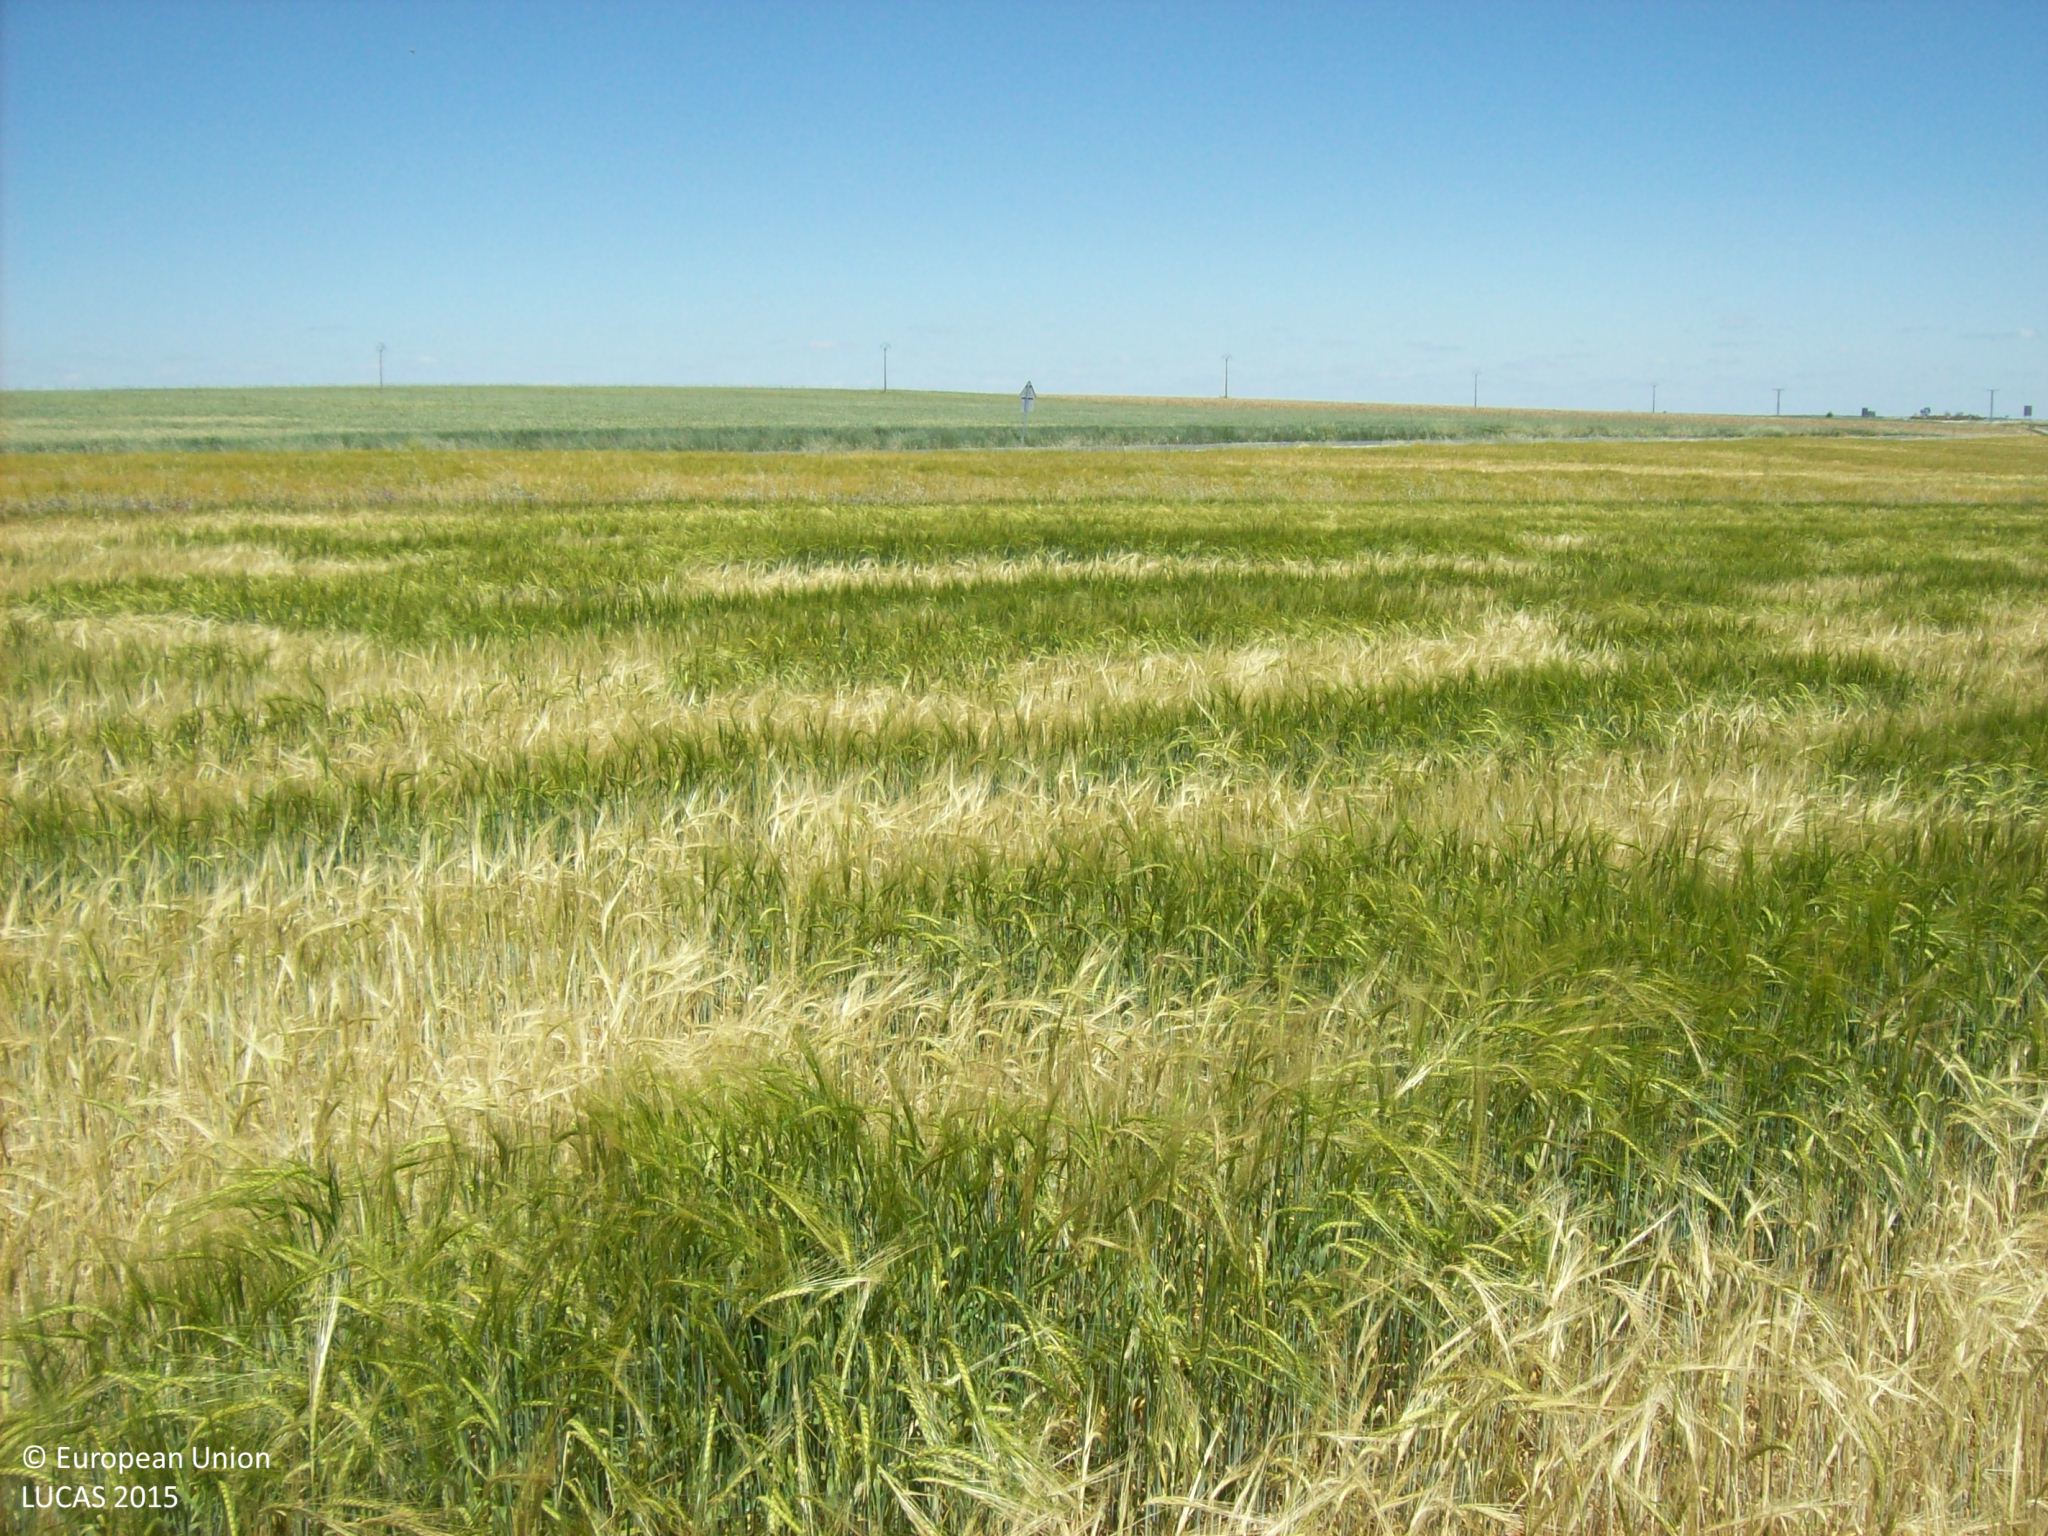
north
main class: Cropland
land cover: Barley
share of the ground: > 75 %
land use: Agriculture (excluding fallow land and kitchen gardens)
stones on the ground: < 10 %
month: May
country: ES
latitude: 40.8372
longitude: -4.9698
